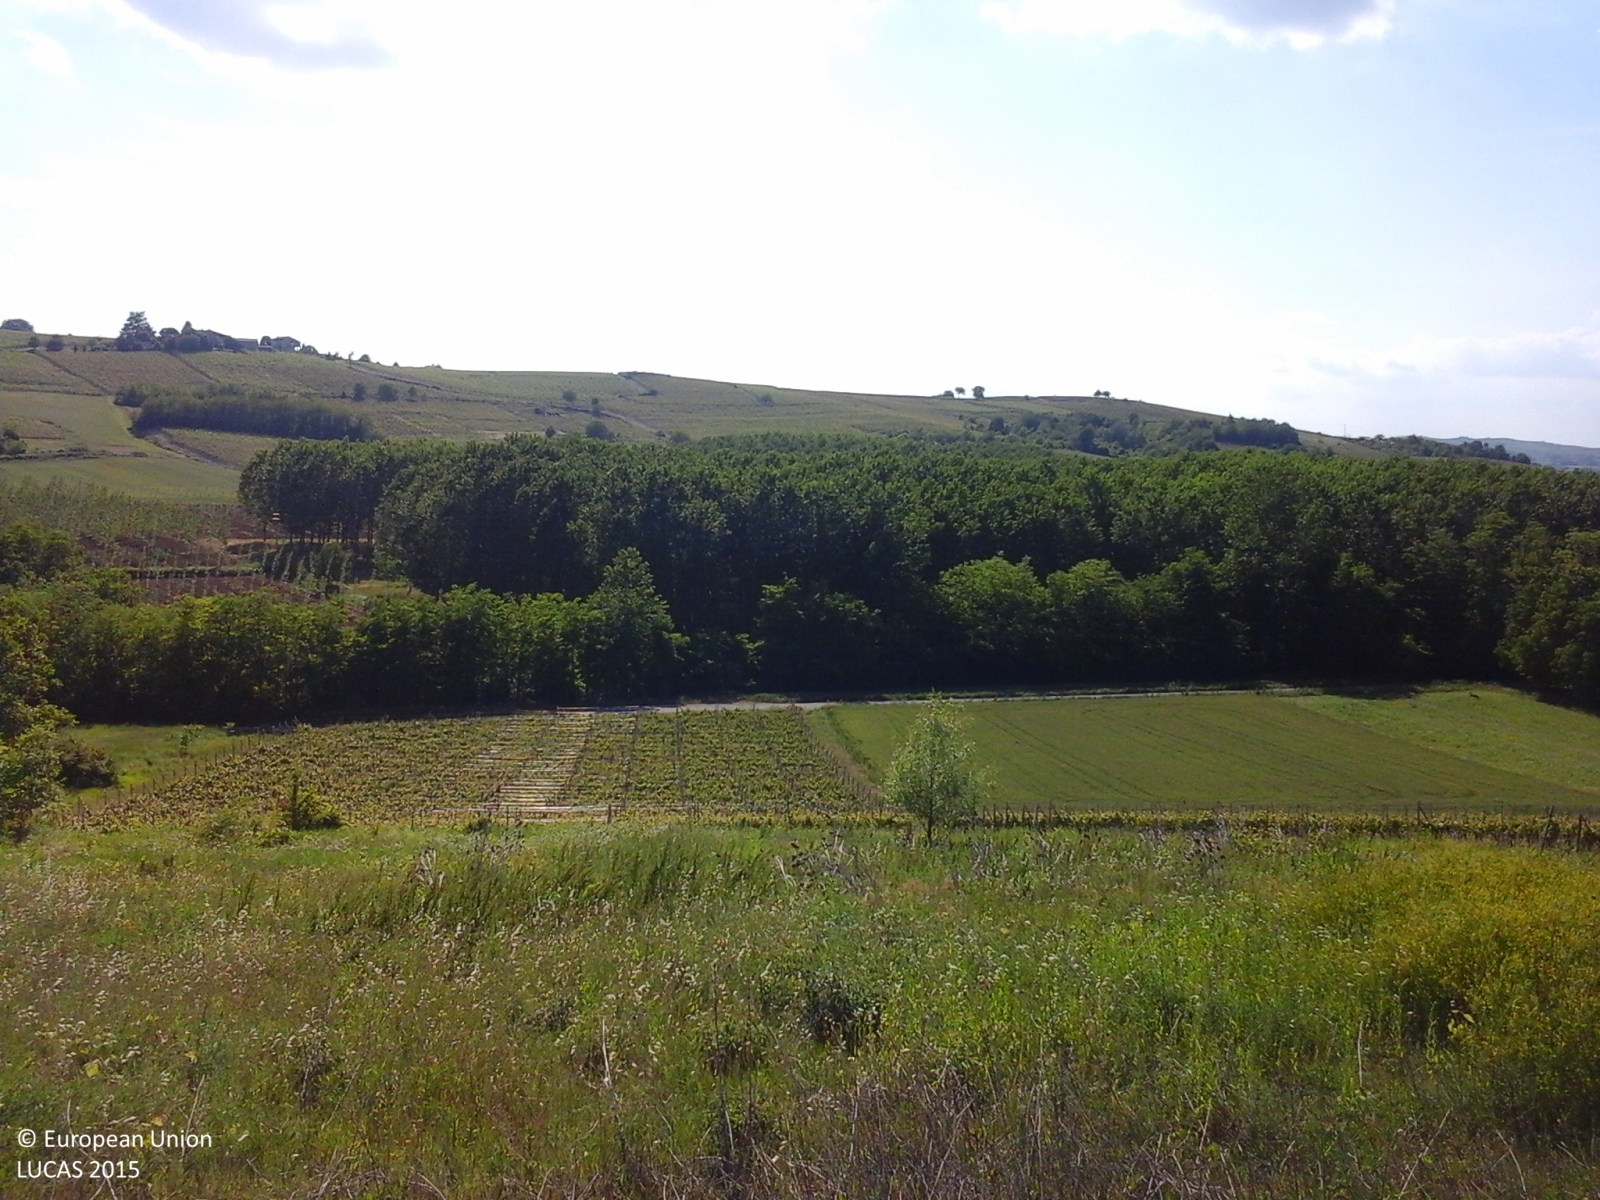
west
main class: Grassland
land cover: Spontaneously vegetated surfaces
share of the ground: > 75 %
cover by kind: herbaceous plants 100 %
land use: Fallow land
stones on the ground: < 10 %
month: May
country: IT
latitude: 44.7015
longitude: 8.5768
